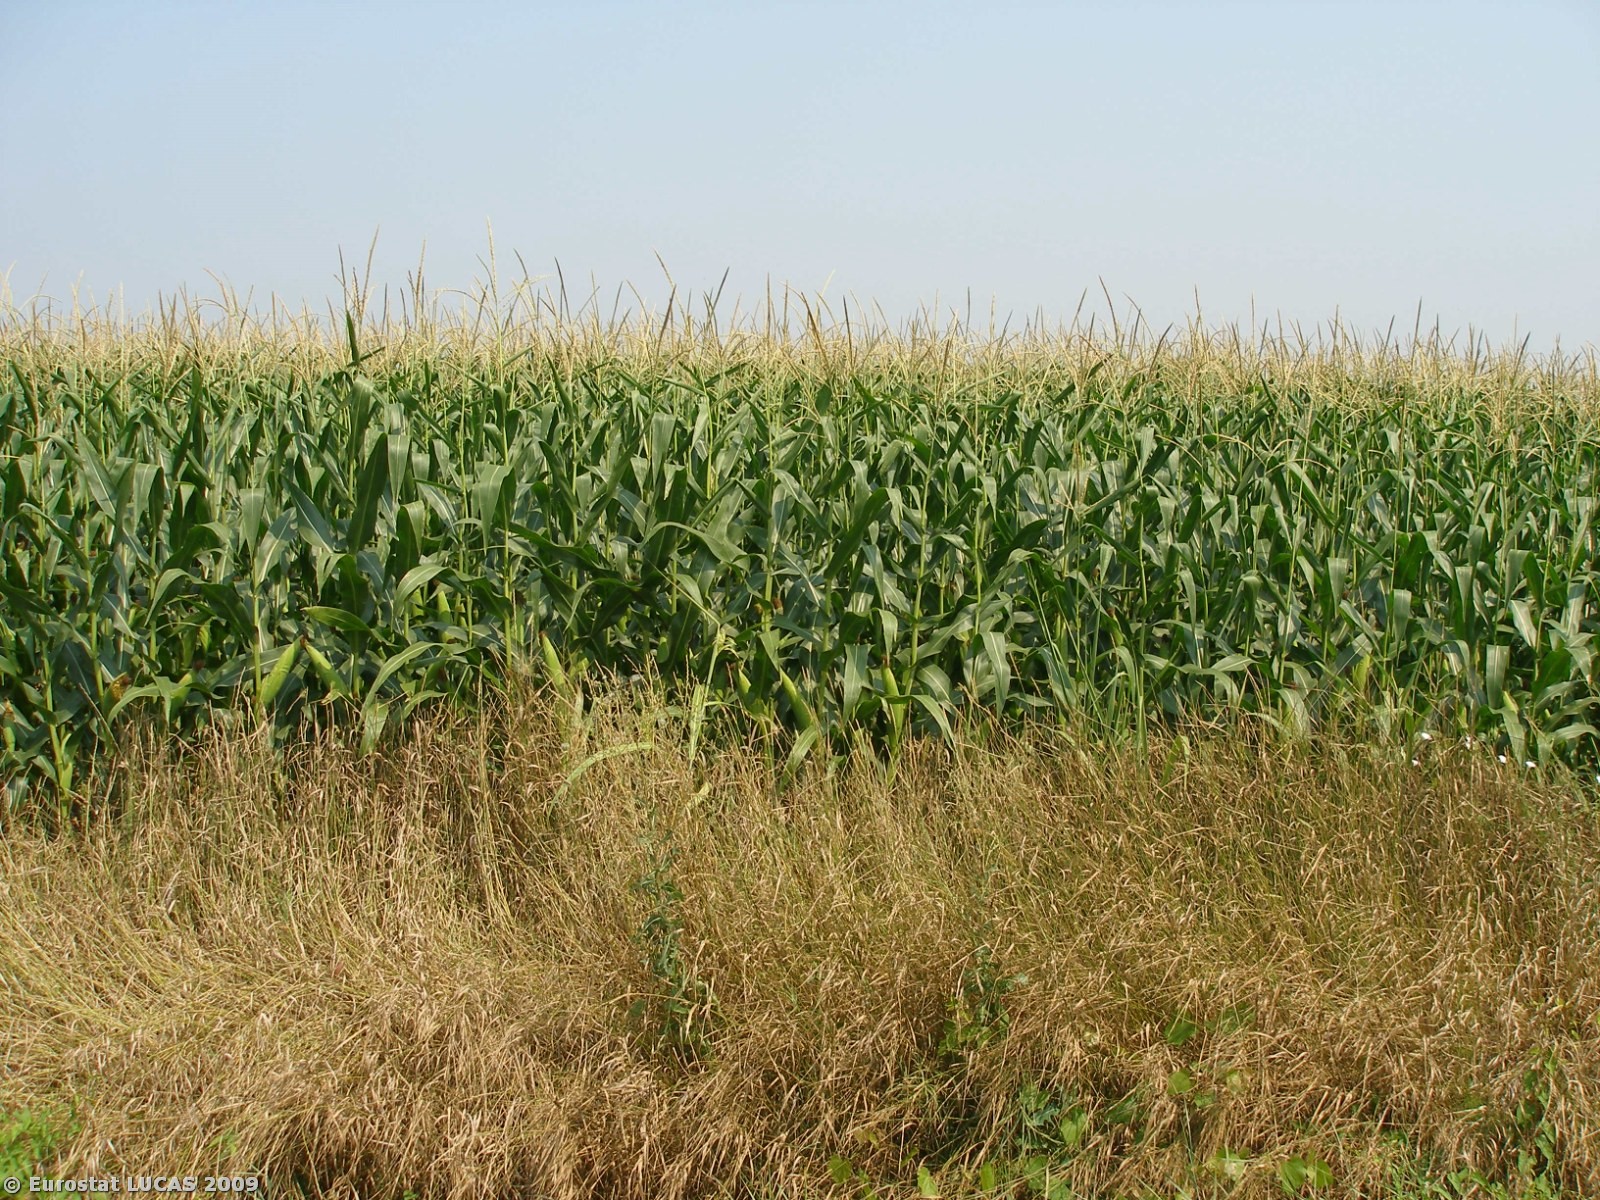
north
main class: Cropland
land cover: Maize
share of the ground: > 75 %
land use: Agriculture (excluding fallow land and kitchen gardens)
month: July
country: IT
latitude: 44.9317
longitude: 11.7073
